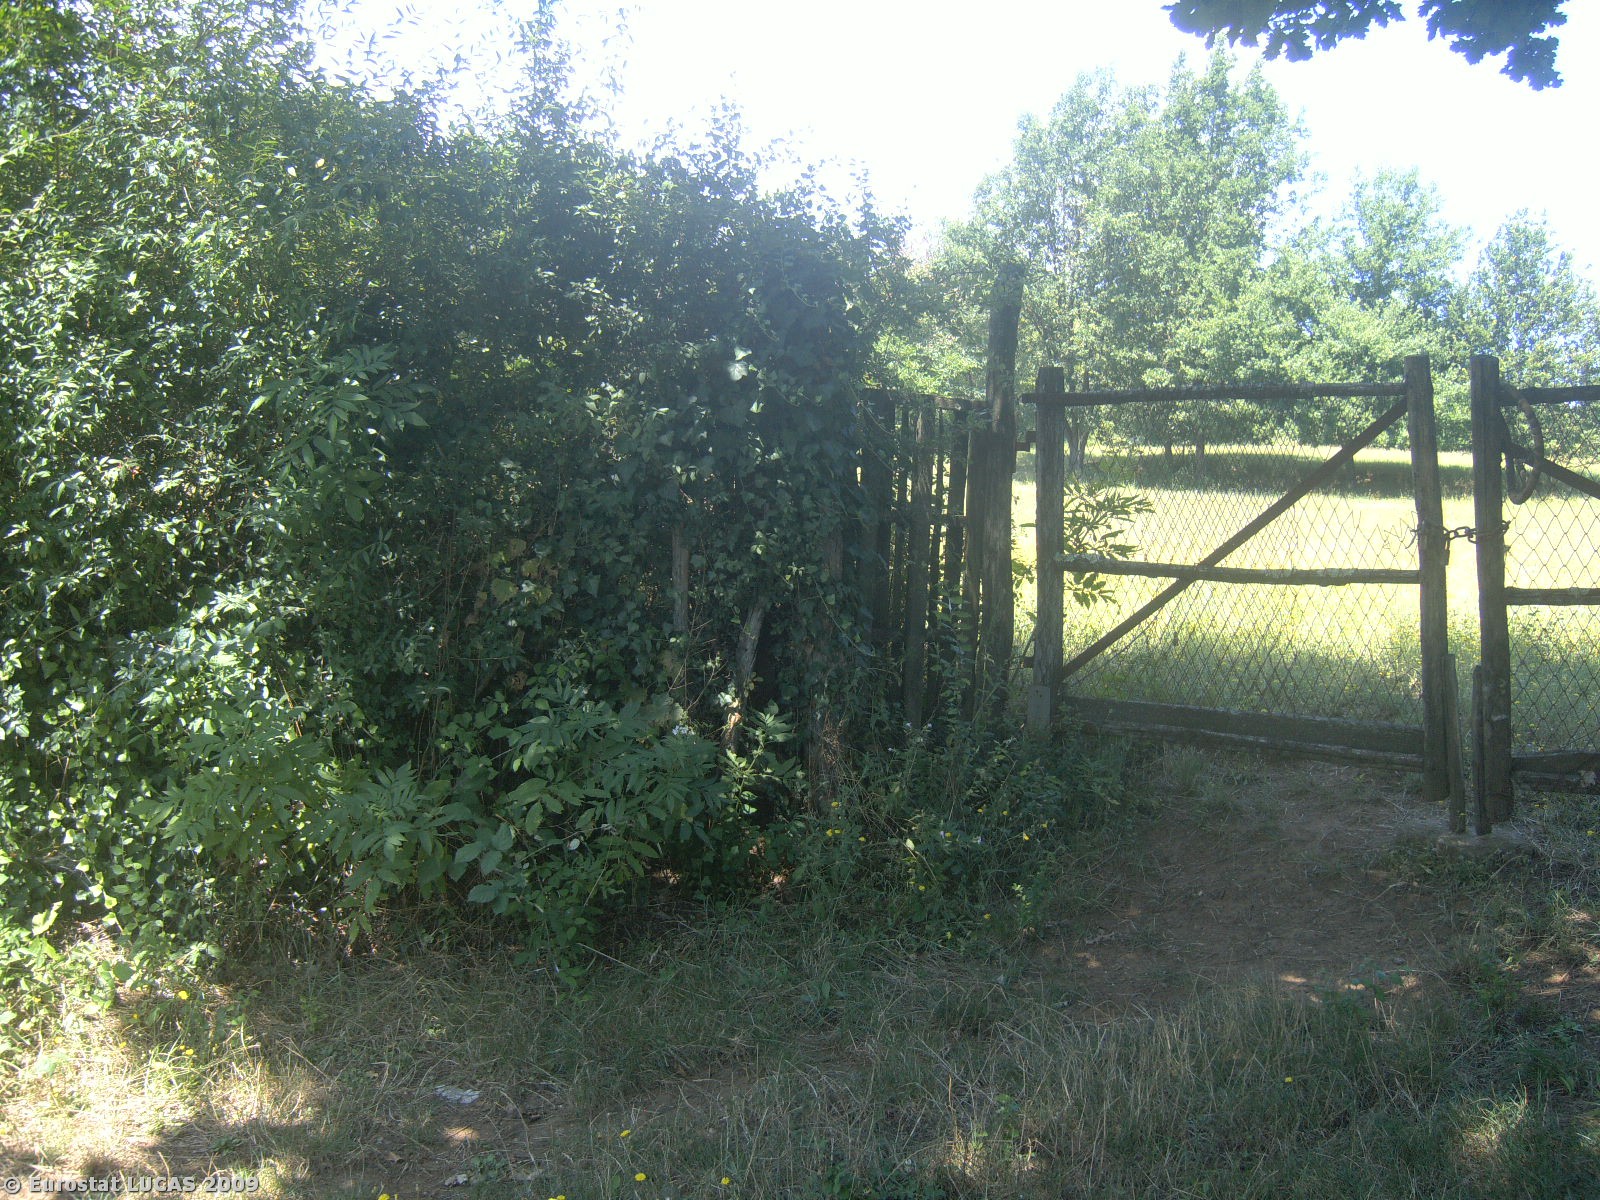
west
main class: Cropland
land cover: Other fresh vegetables
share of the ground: > 75 %
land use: Kitchen garden
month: July
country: IT
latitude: 41.6069
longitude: 13.2633
